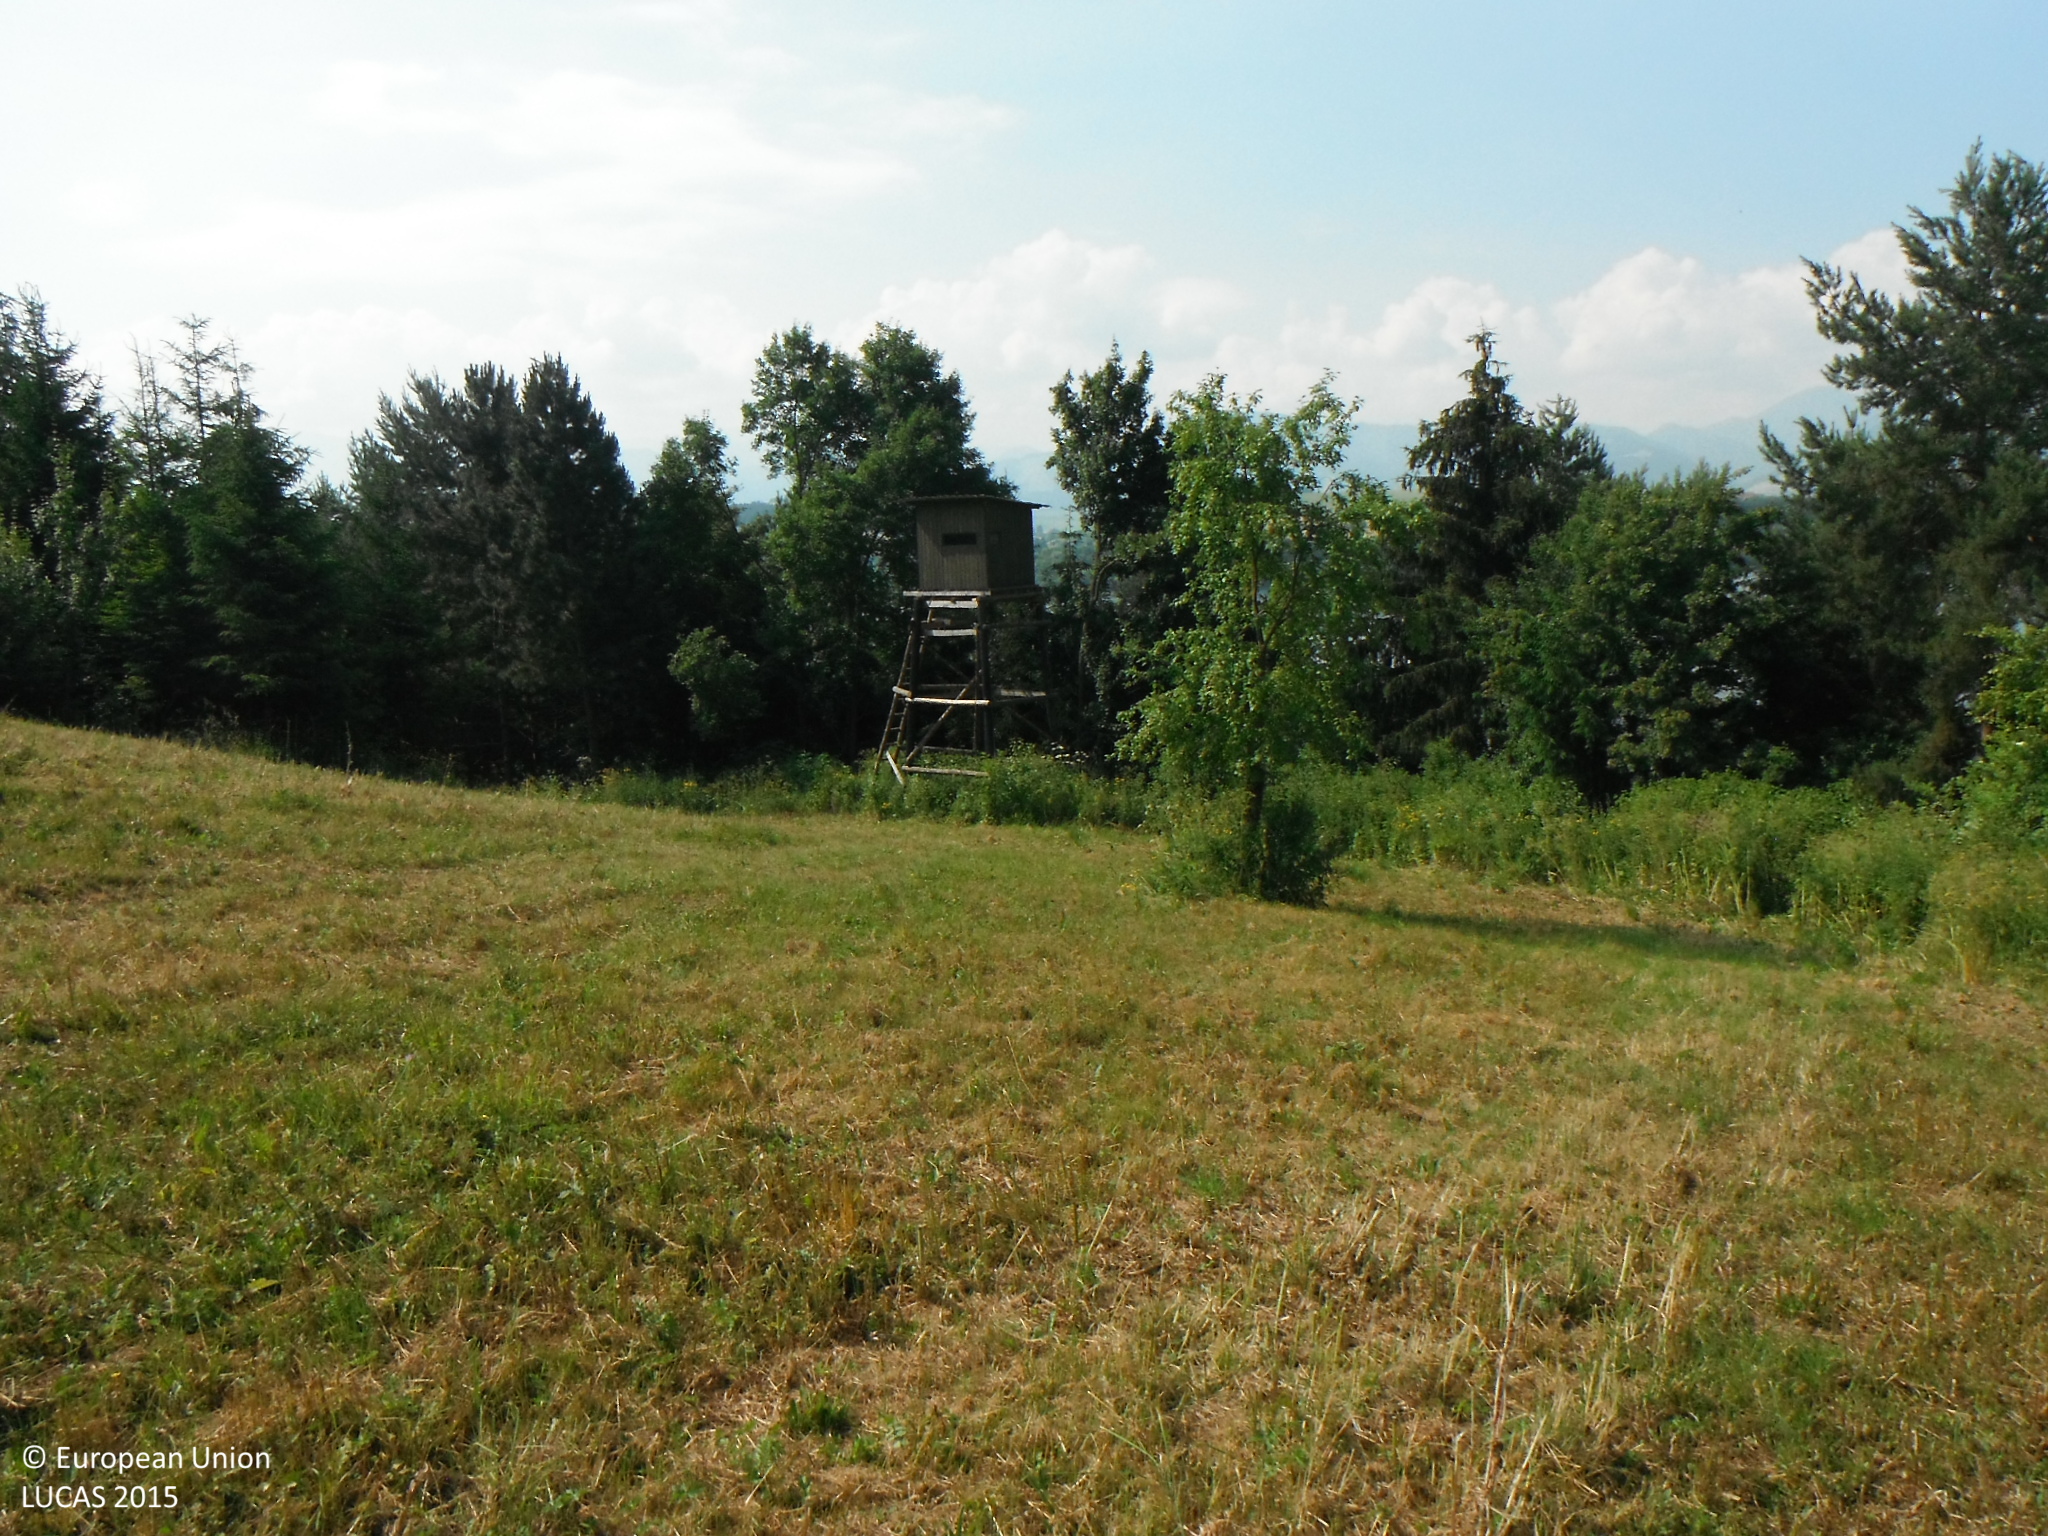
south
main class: Grassland
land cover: Grassland without tree/shrub cover
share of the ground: > 75 %
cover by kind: herbaceous plants 100 %
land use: Agriculture (excluding fallow land and kitchen gardens)
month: July
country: SK
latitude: 49.1017
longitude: 19.4629
